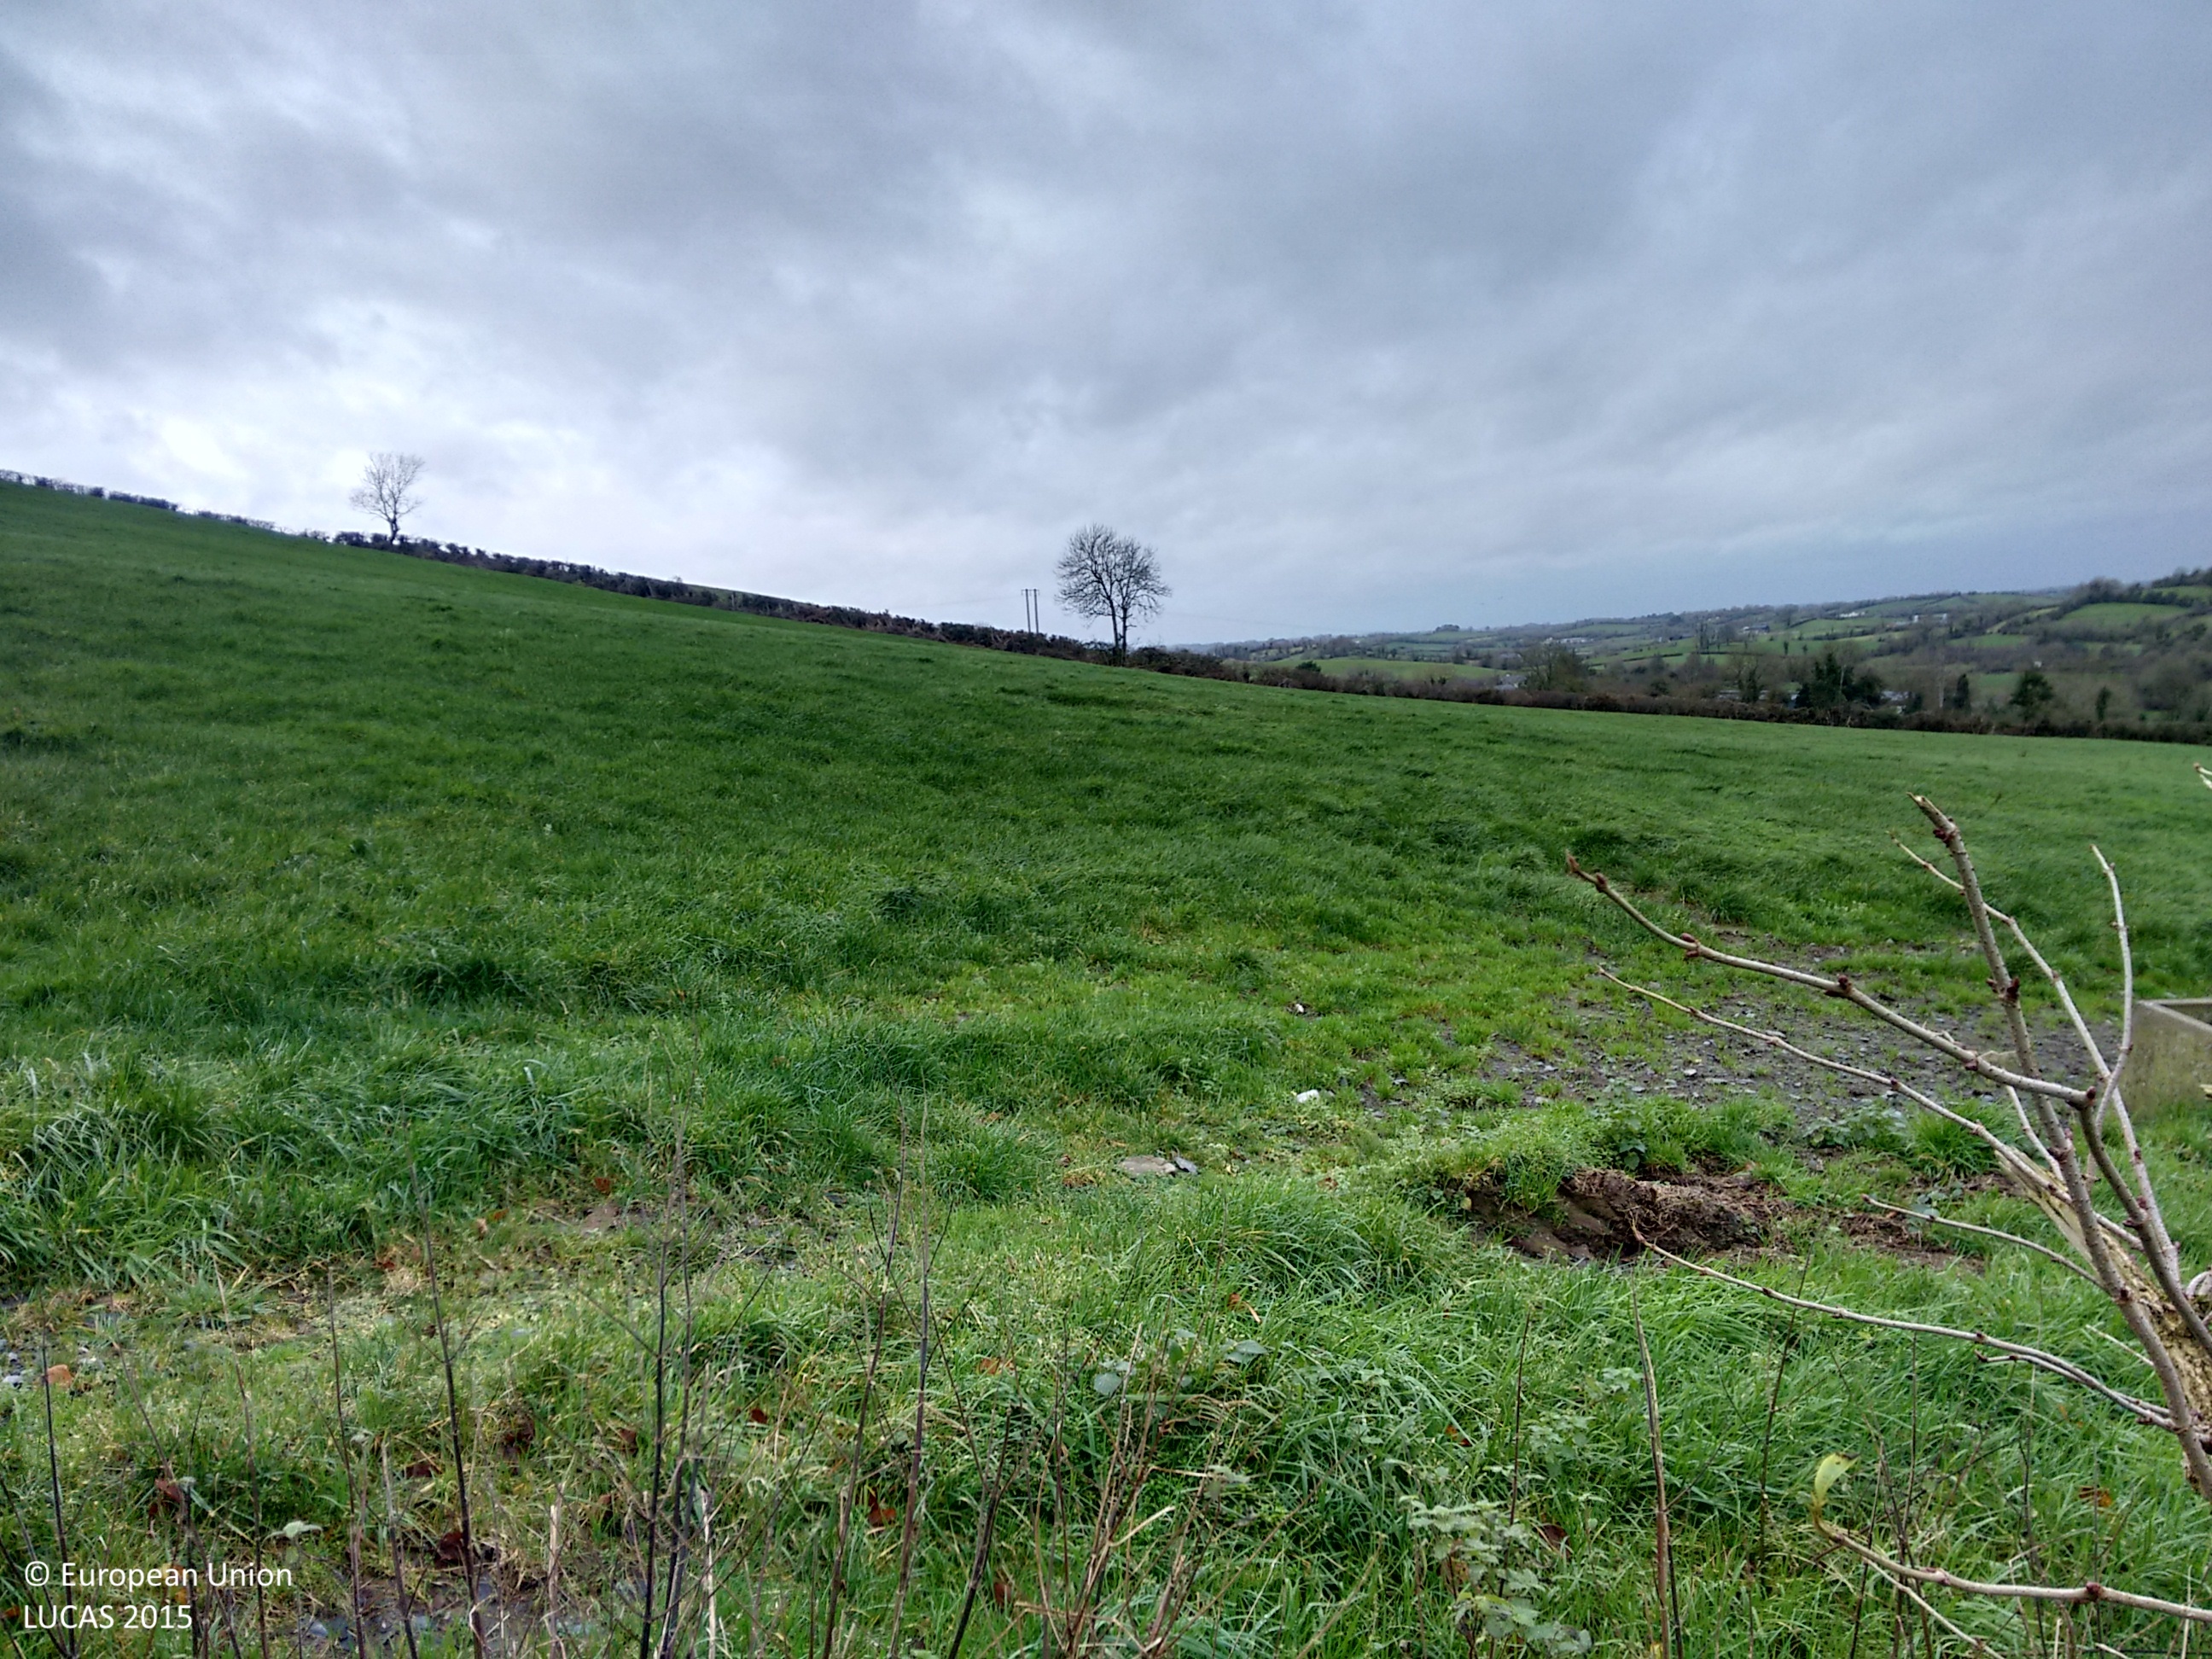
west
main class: Grassland
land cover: Grassland without tree/shrub cover
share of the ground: > 75 %
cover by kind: herbaceous plants 100 %
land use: Agriculture (excluding fallow land and kitchen gardens)
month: December
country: IE
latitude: 54.1124
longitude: -6.9188
